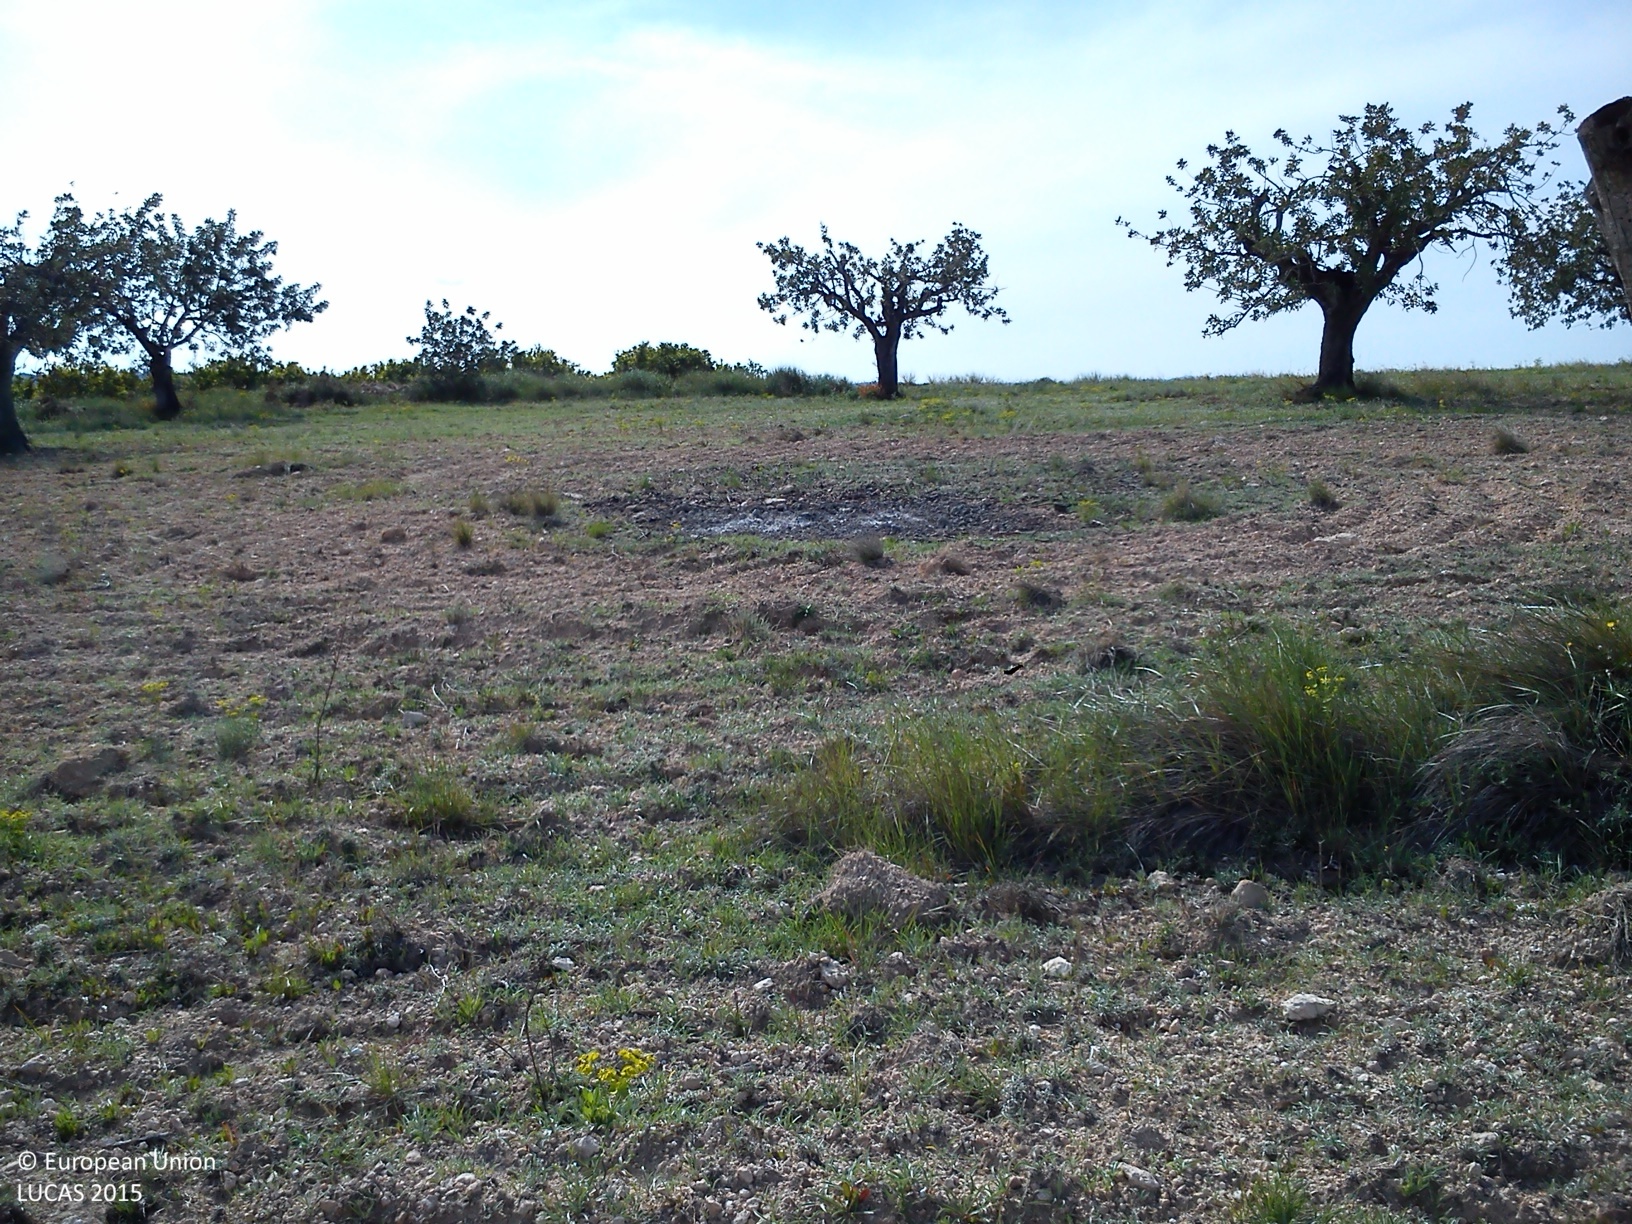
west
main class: Cropland
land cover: Permanent industrial crops
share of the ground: < 10 %
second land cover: Spontaneously vegetated surfaces
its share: 25 - 50 %
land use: Agriculture (excluding fallow land and kitchen gardens)
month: April
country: ES
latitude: 39.4483
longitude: -0.6542
